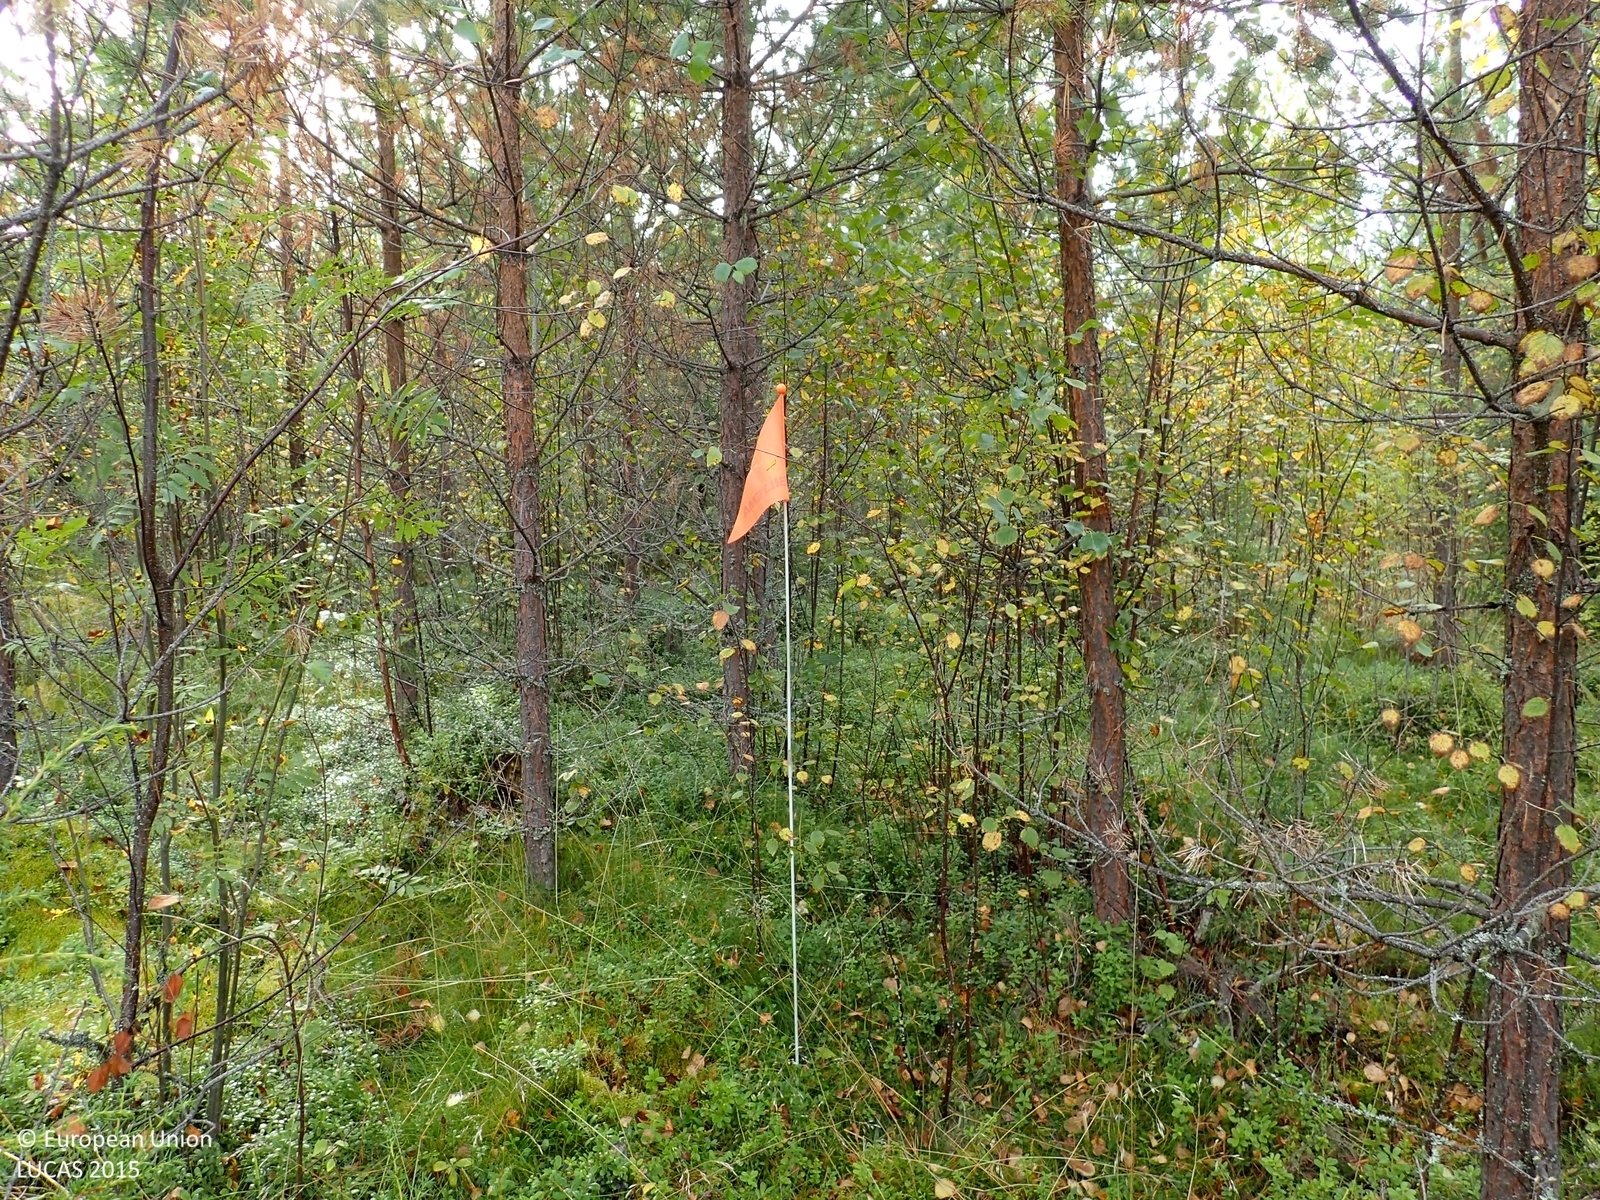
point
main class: Woodland
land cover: Pine dominated mixed woodland
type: boreal forest
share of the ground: > 75 %
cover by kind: coniferous forest trees 60 %, broadleaved forest trees 20 %, shrubs 10 %, herbaceous plants 5 %, lichens and mosses 5 %
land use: Forestry
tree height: < 5 m
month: September
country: FI
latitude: 63.1337
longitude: 26.0050
